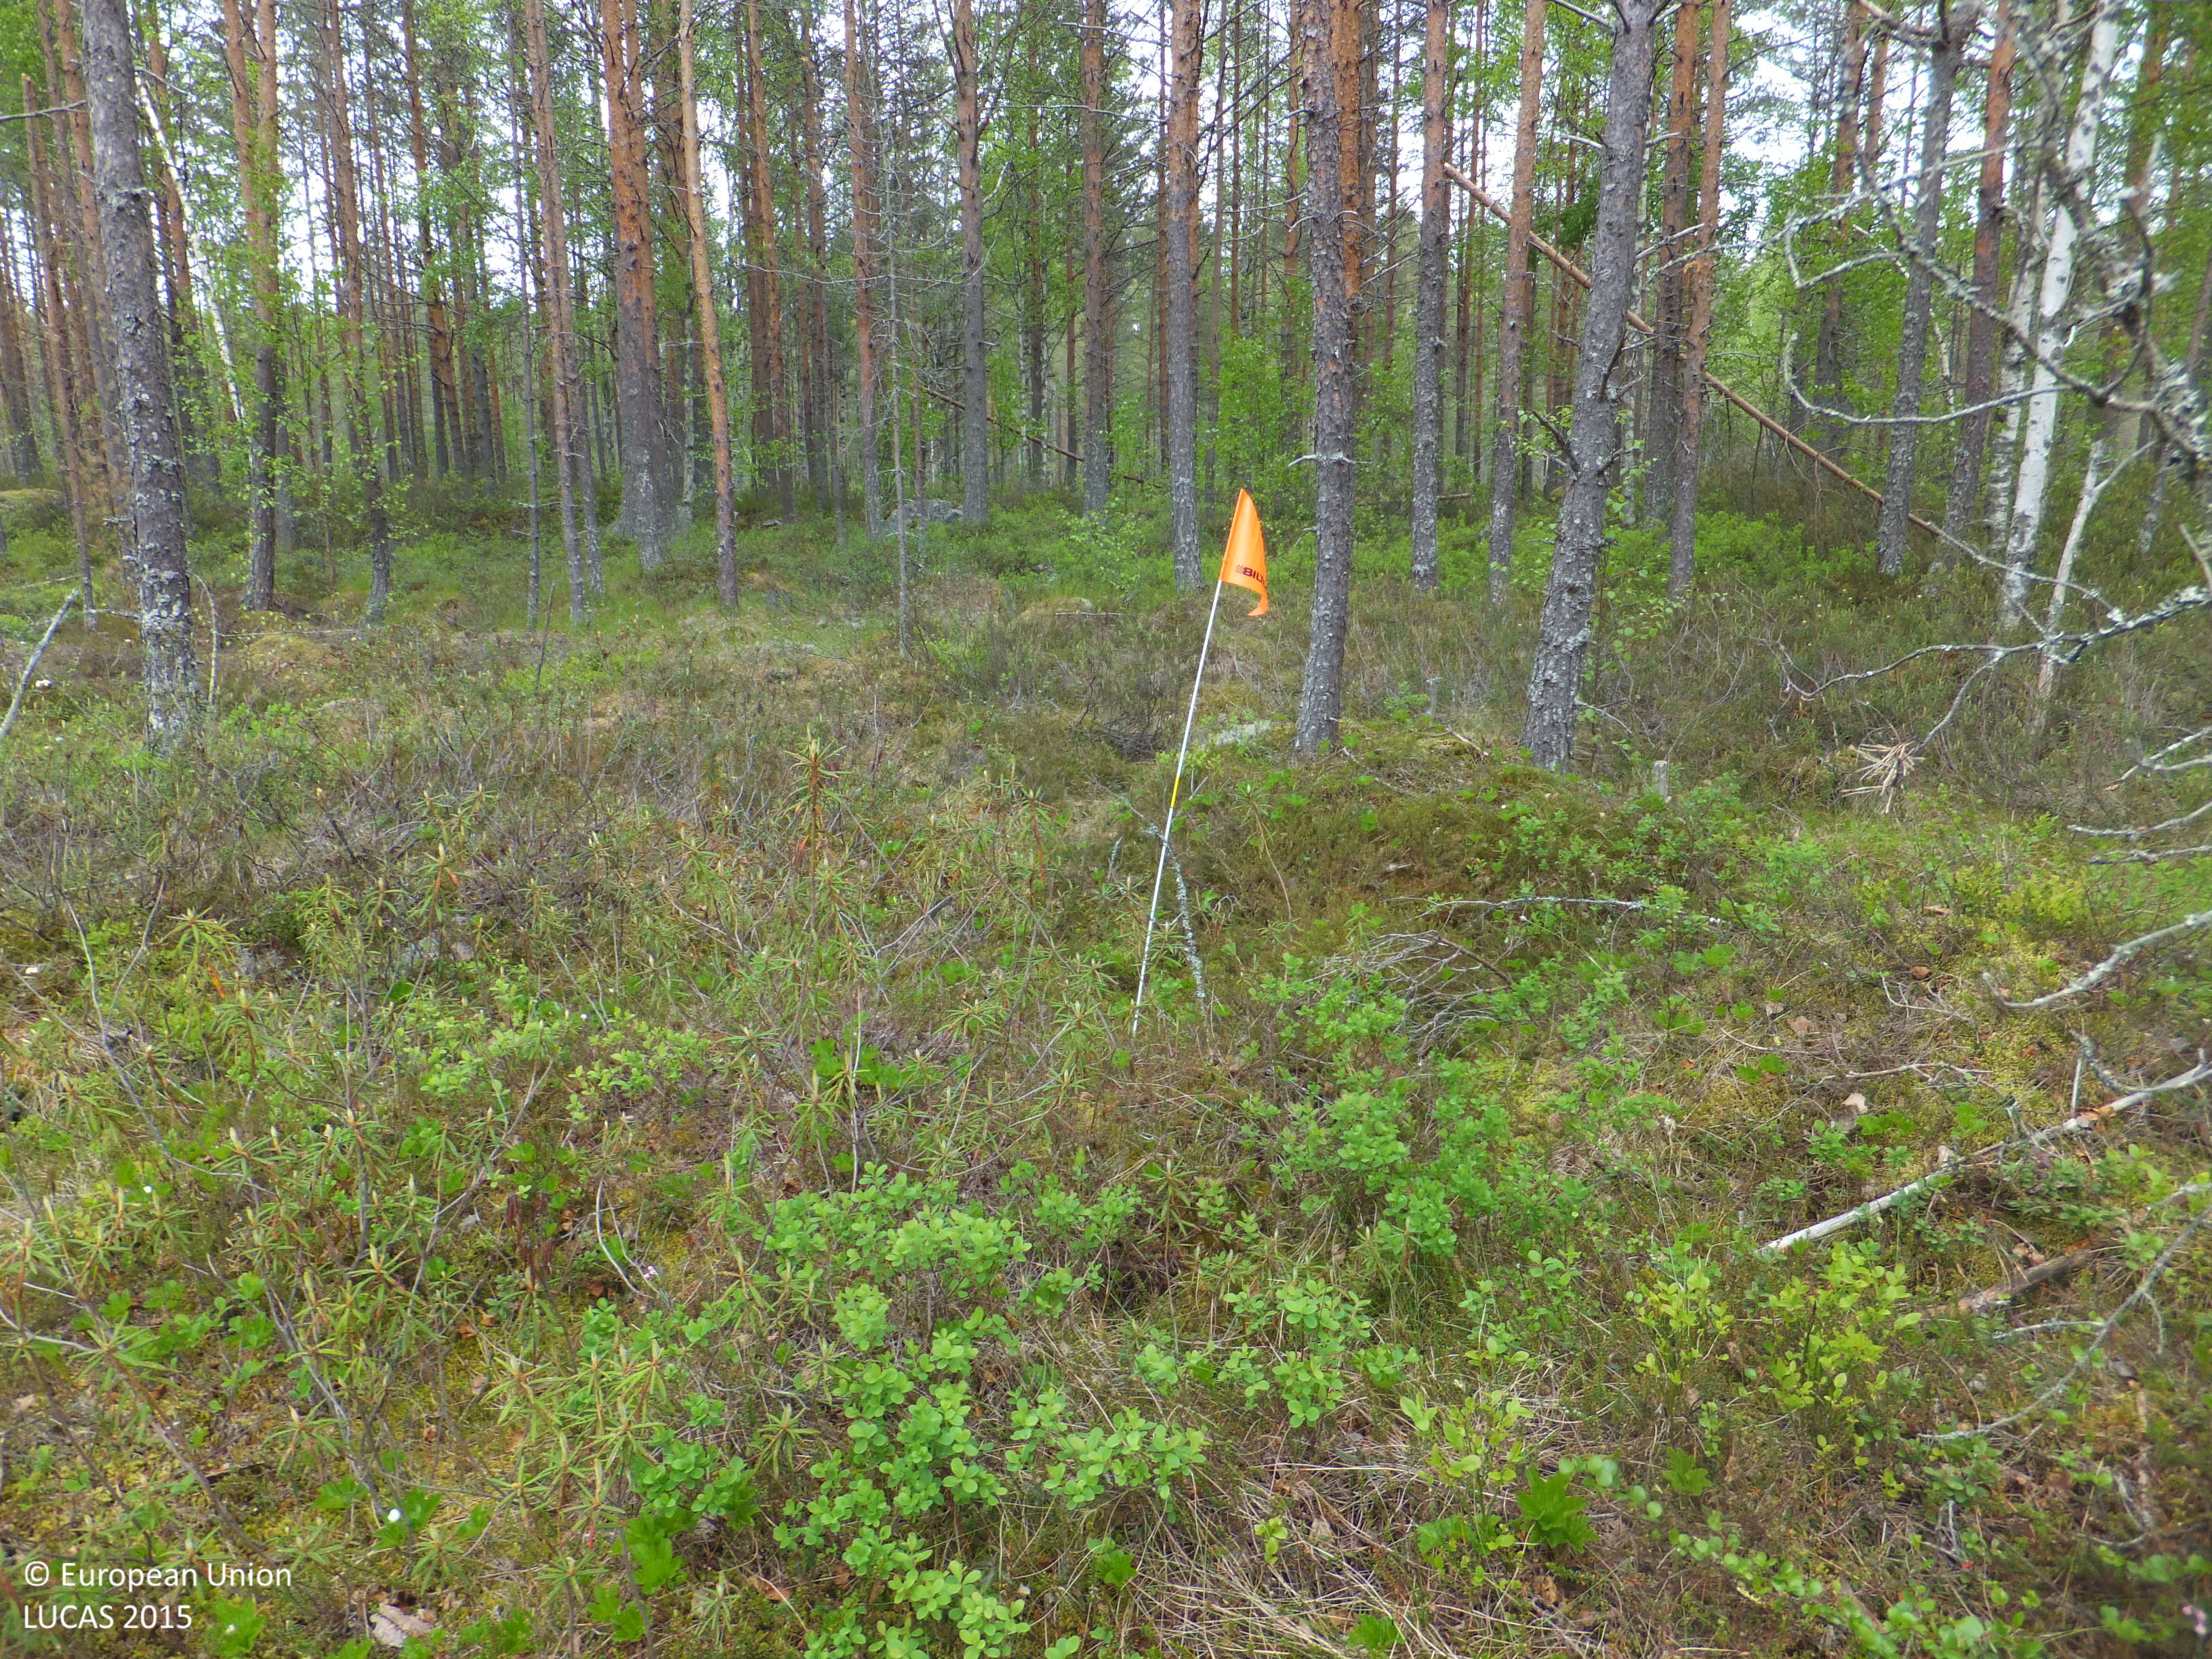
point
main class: Woodland
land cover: Pine dominated coniferous woodland
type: mire and swamp forests
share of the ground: > 75 %
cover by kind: coniferous forest trees 75 %, shrubs 15 %, herbaceous plants 10 %
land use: Forestry
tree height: > 5 m
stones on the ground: 10 - 25 %
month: June
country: FI
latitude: 63.6073
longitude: 24.2078
